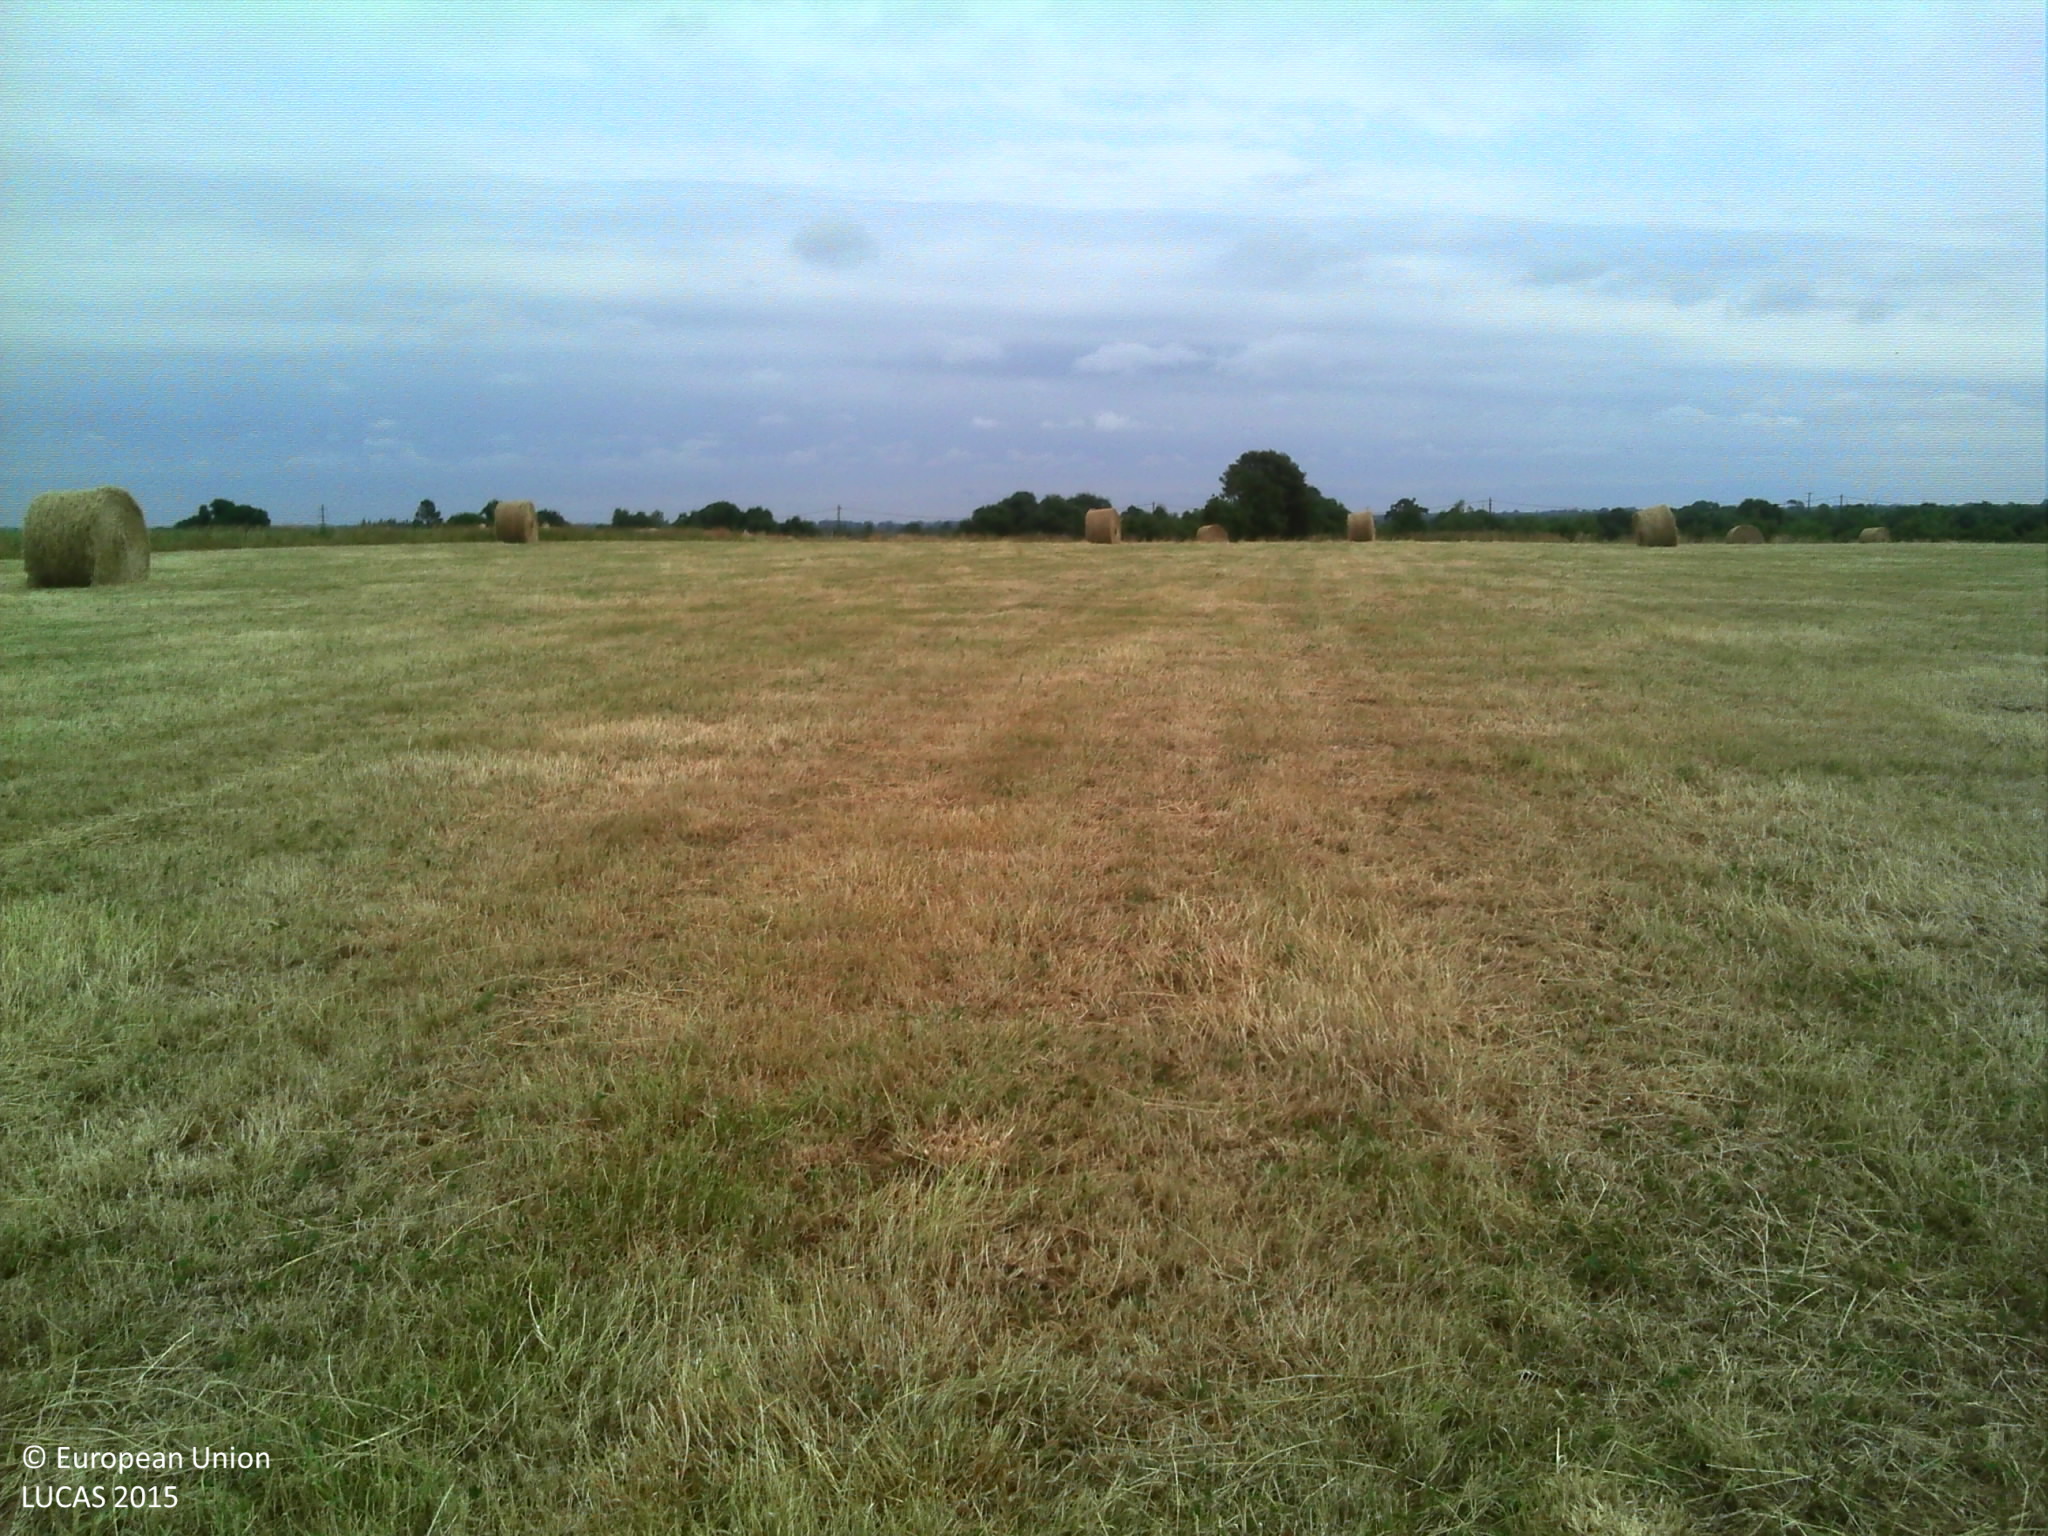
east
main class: Cropland
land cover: Temporary grasslands
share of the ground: > 75 %
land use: Agriculture (excluding fallow land and kitchen gardens)
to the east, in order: Temporary grasslands; Fences; Grassland without tree/shrub cover
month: July
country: FR
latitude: 47.2136
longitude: -1.8904
